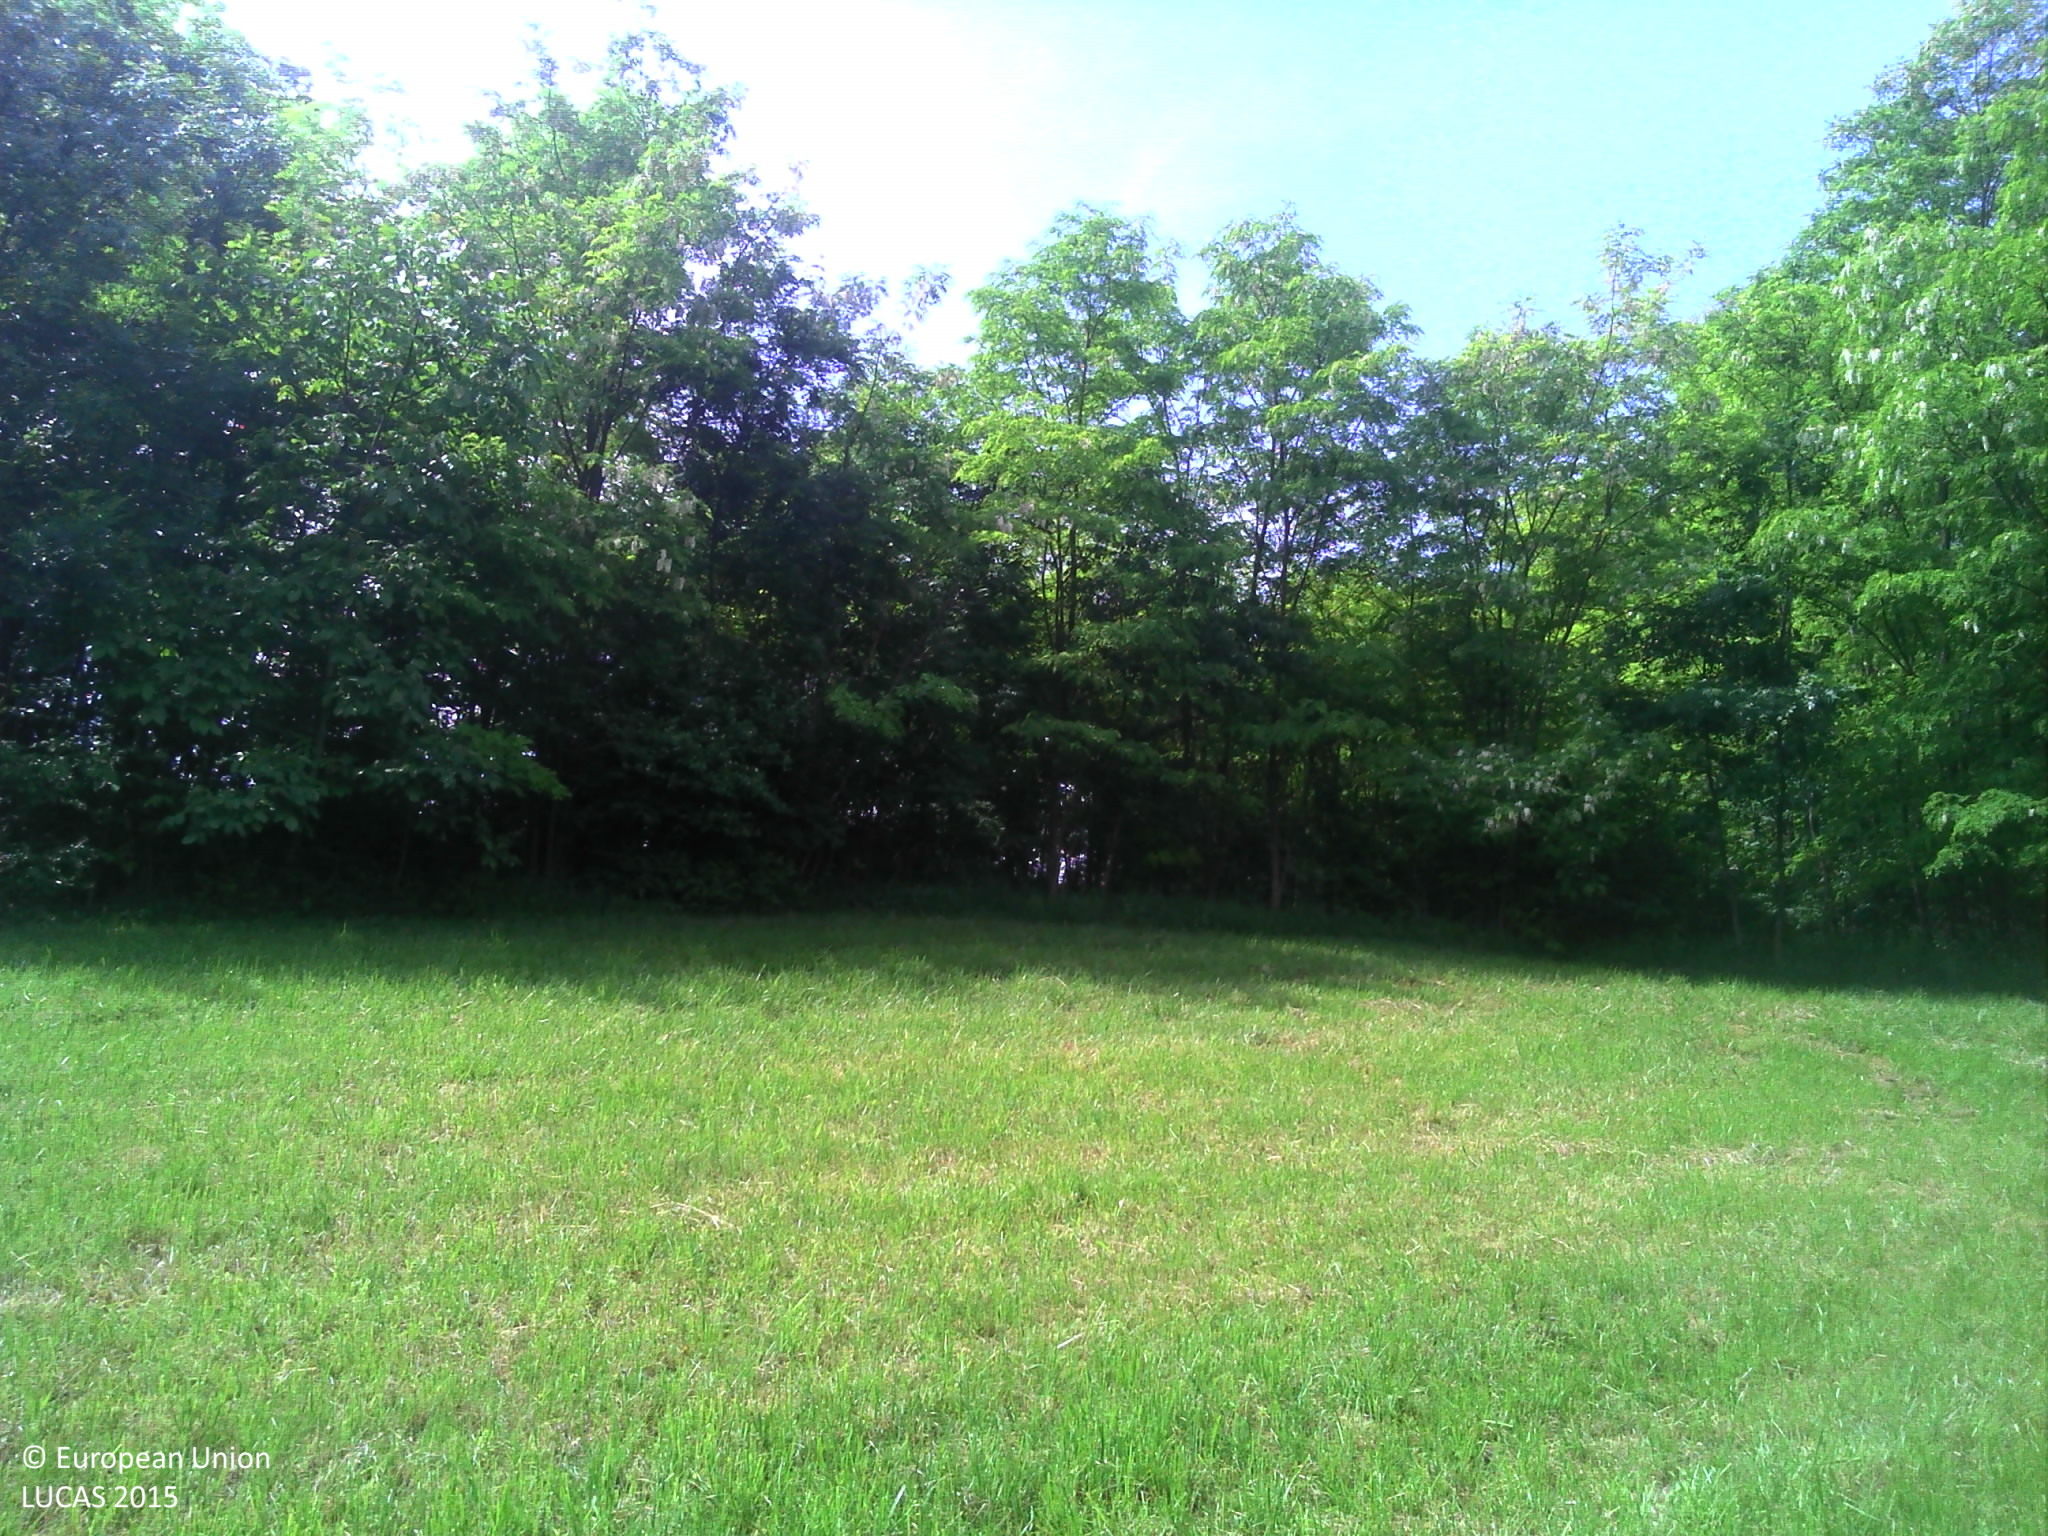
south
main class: Woodland
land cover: Broadleaved woodland
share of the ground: > 75 %
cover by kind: broadleaved forest trees 100 %
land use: Forestry
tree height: < 5 m
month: May
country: FR
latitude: 48.6630
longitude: 7.4890
